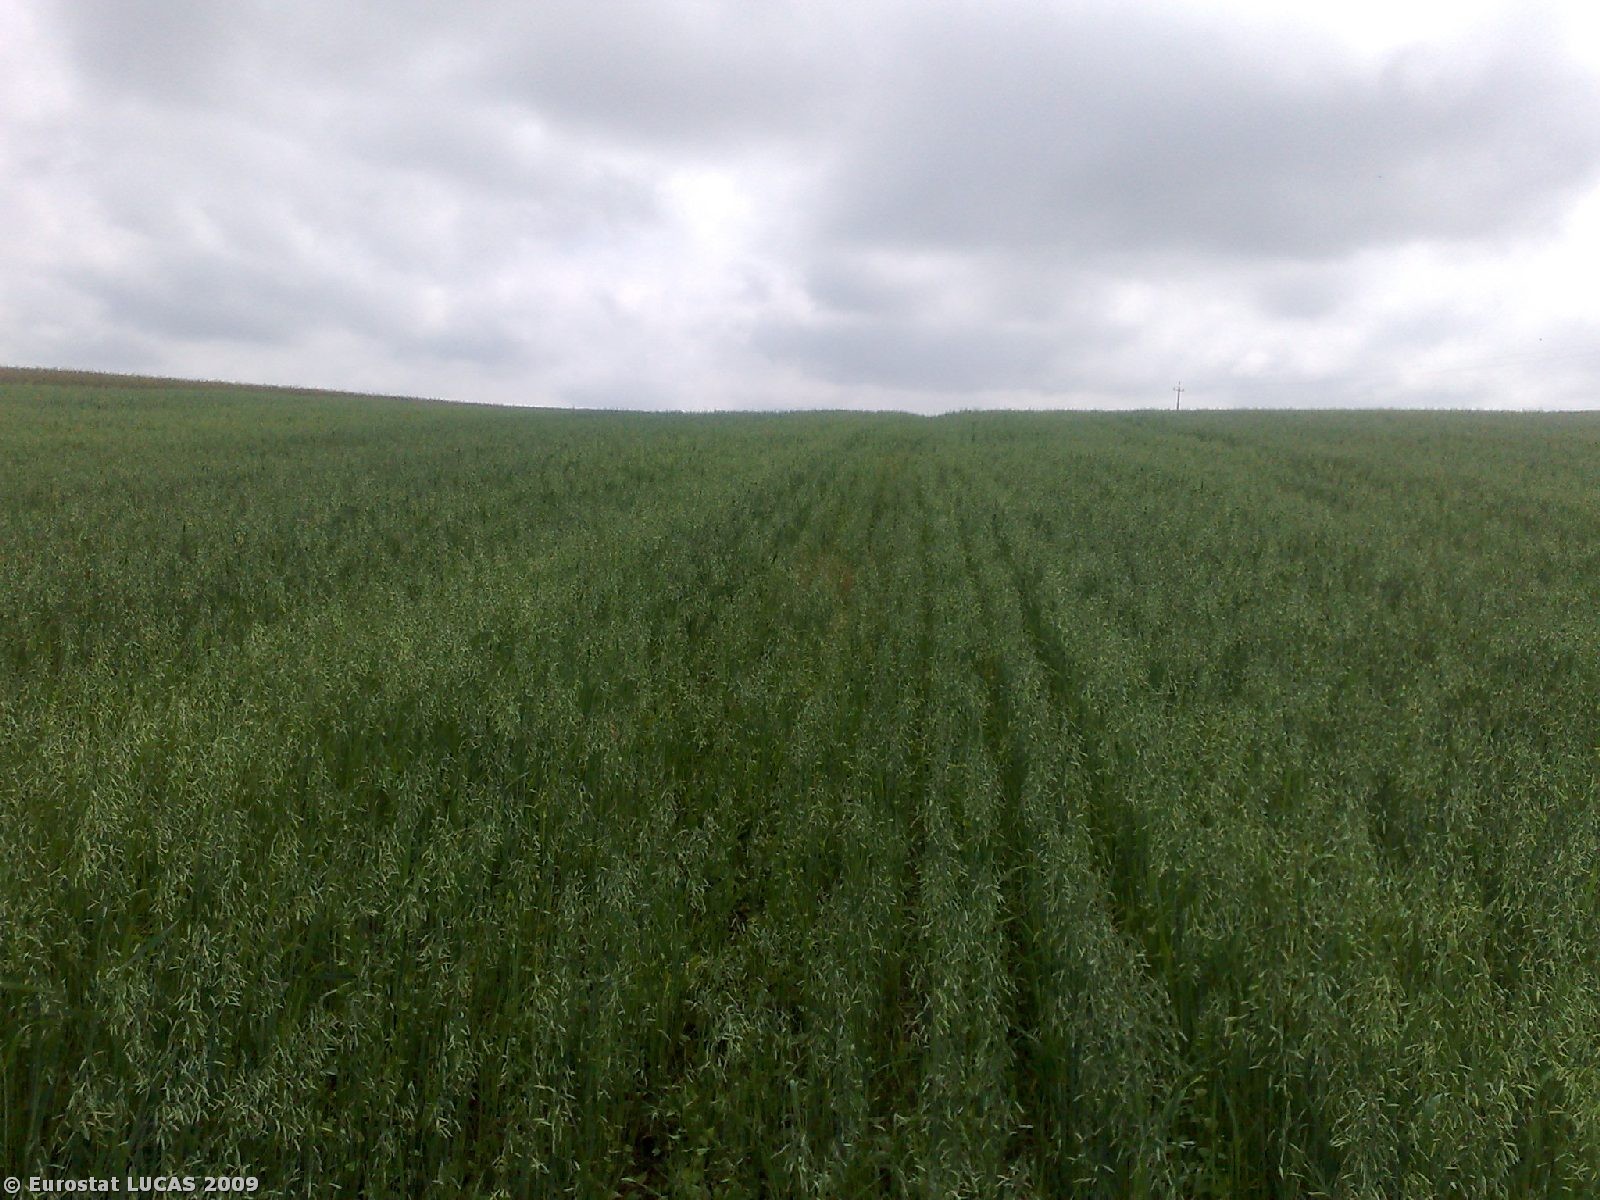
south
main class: Cropland
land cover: Oats
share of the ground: 25 - 50 %
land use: Agriculture (excluding fallow land and kitchen gardens)
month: June
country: PL
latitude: 53.7679
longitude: 23.5410
